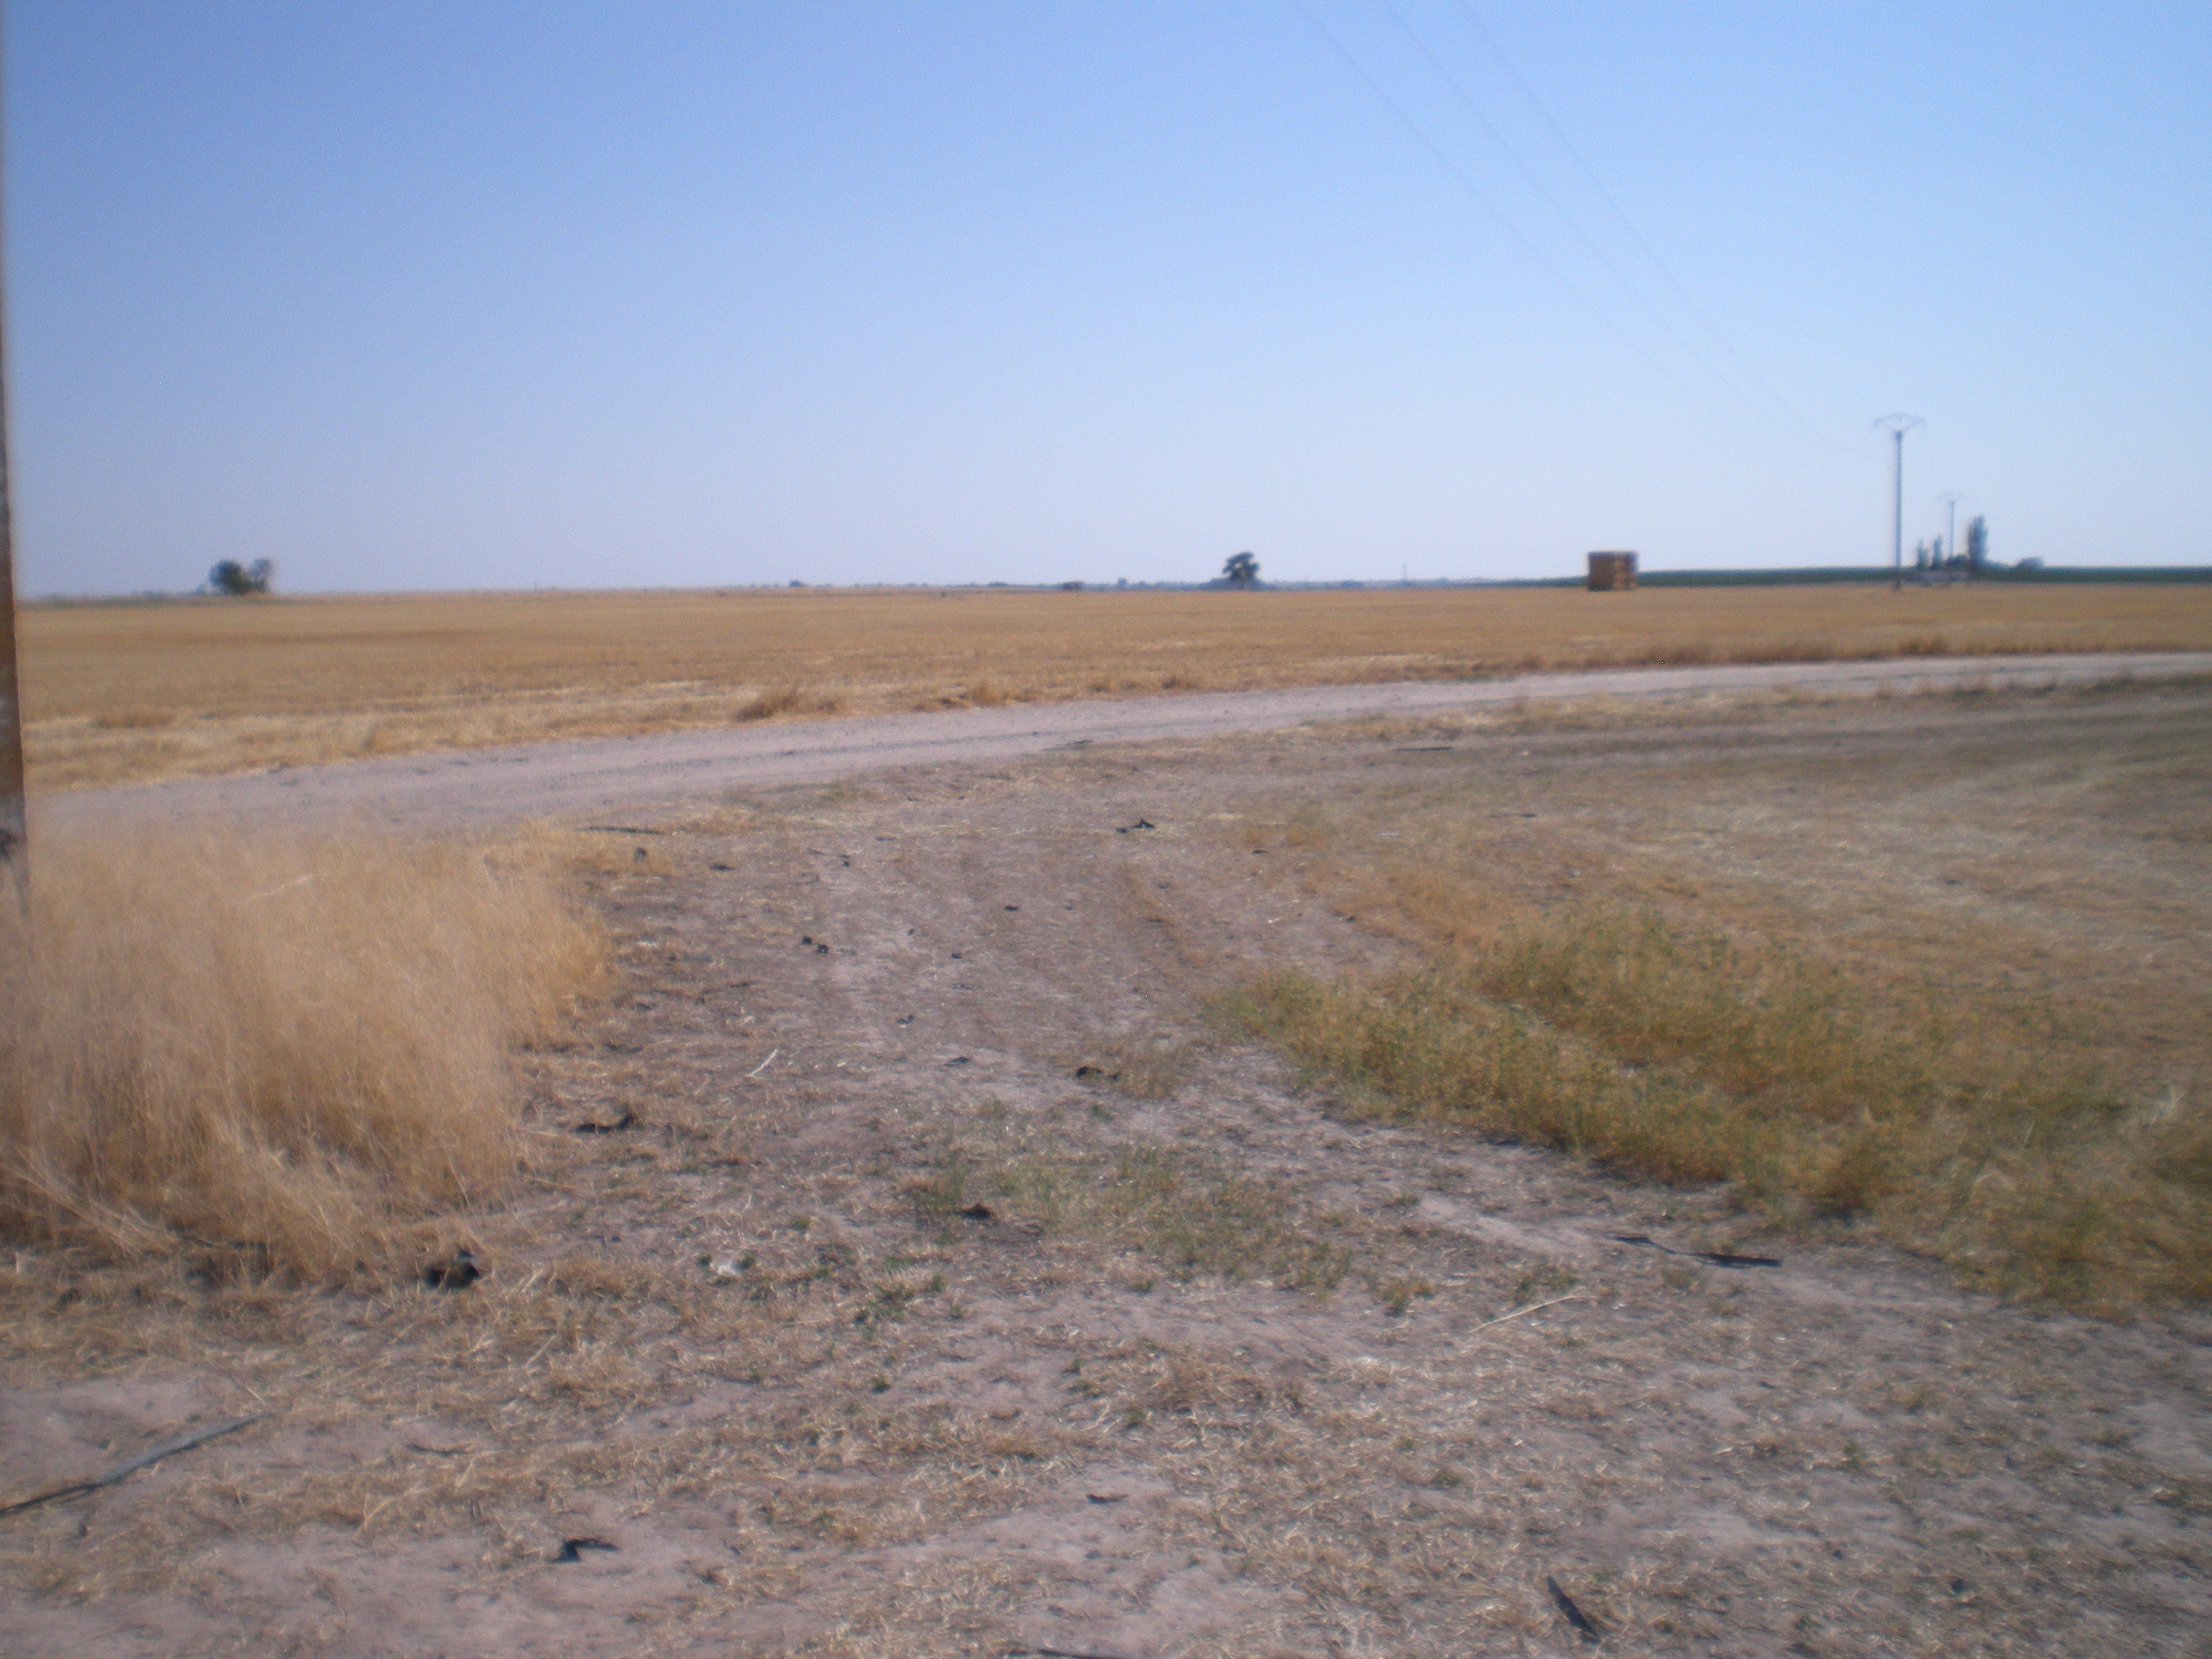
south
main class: Cropland
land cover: Barley
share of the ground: < 10 %
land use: Agriculture (excluding fallow land and kitchen gardens)
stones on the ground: < 10 %
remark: Harvested field
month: July
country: ES
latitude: 39.3103
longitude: -3.1093
